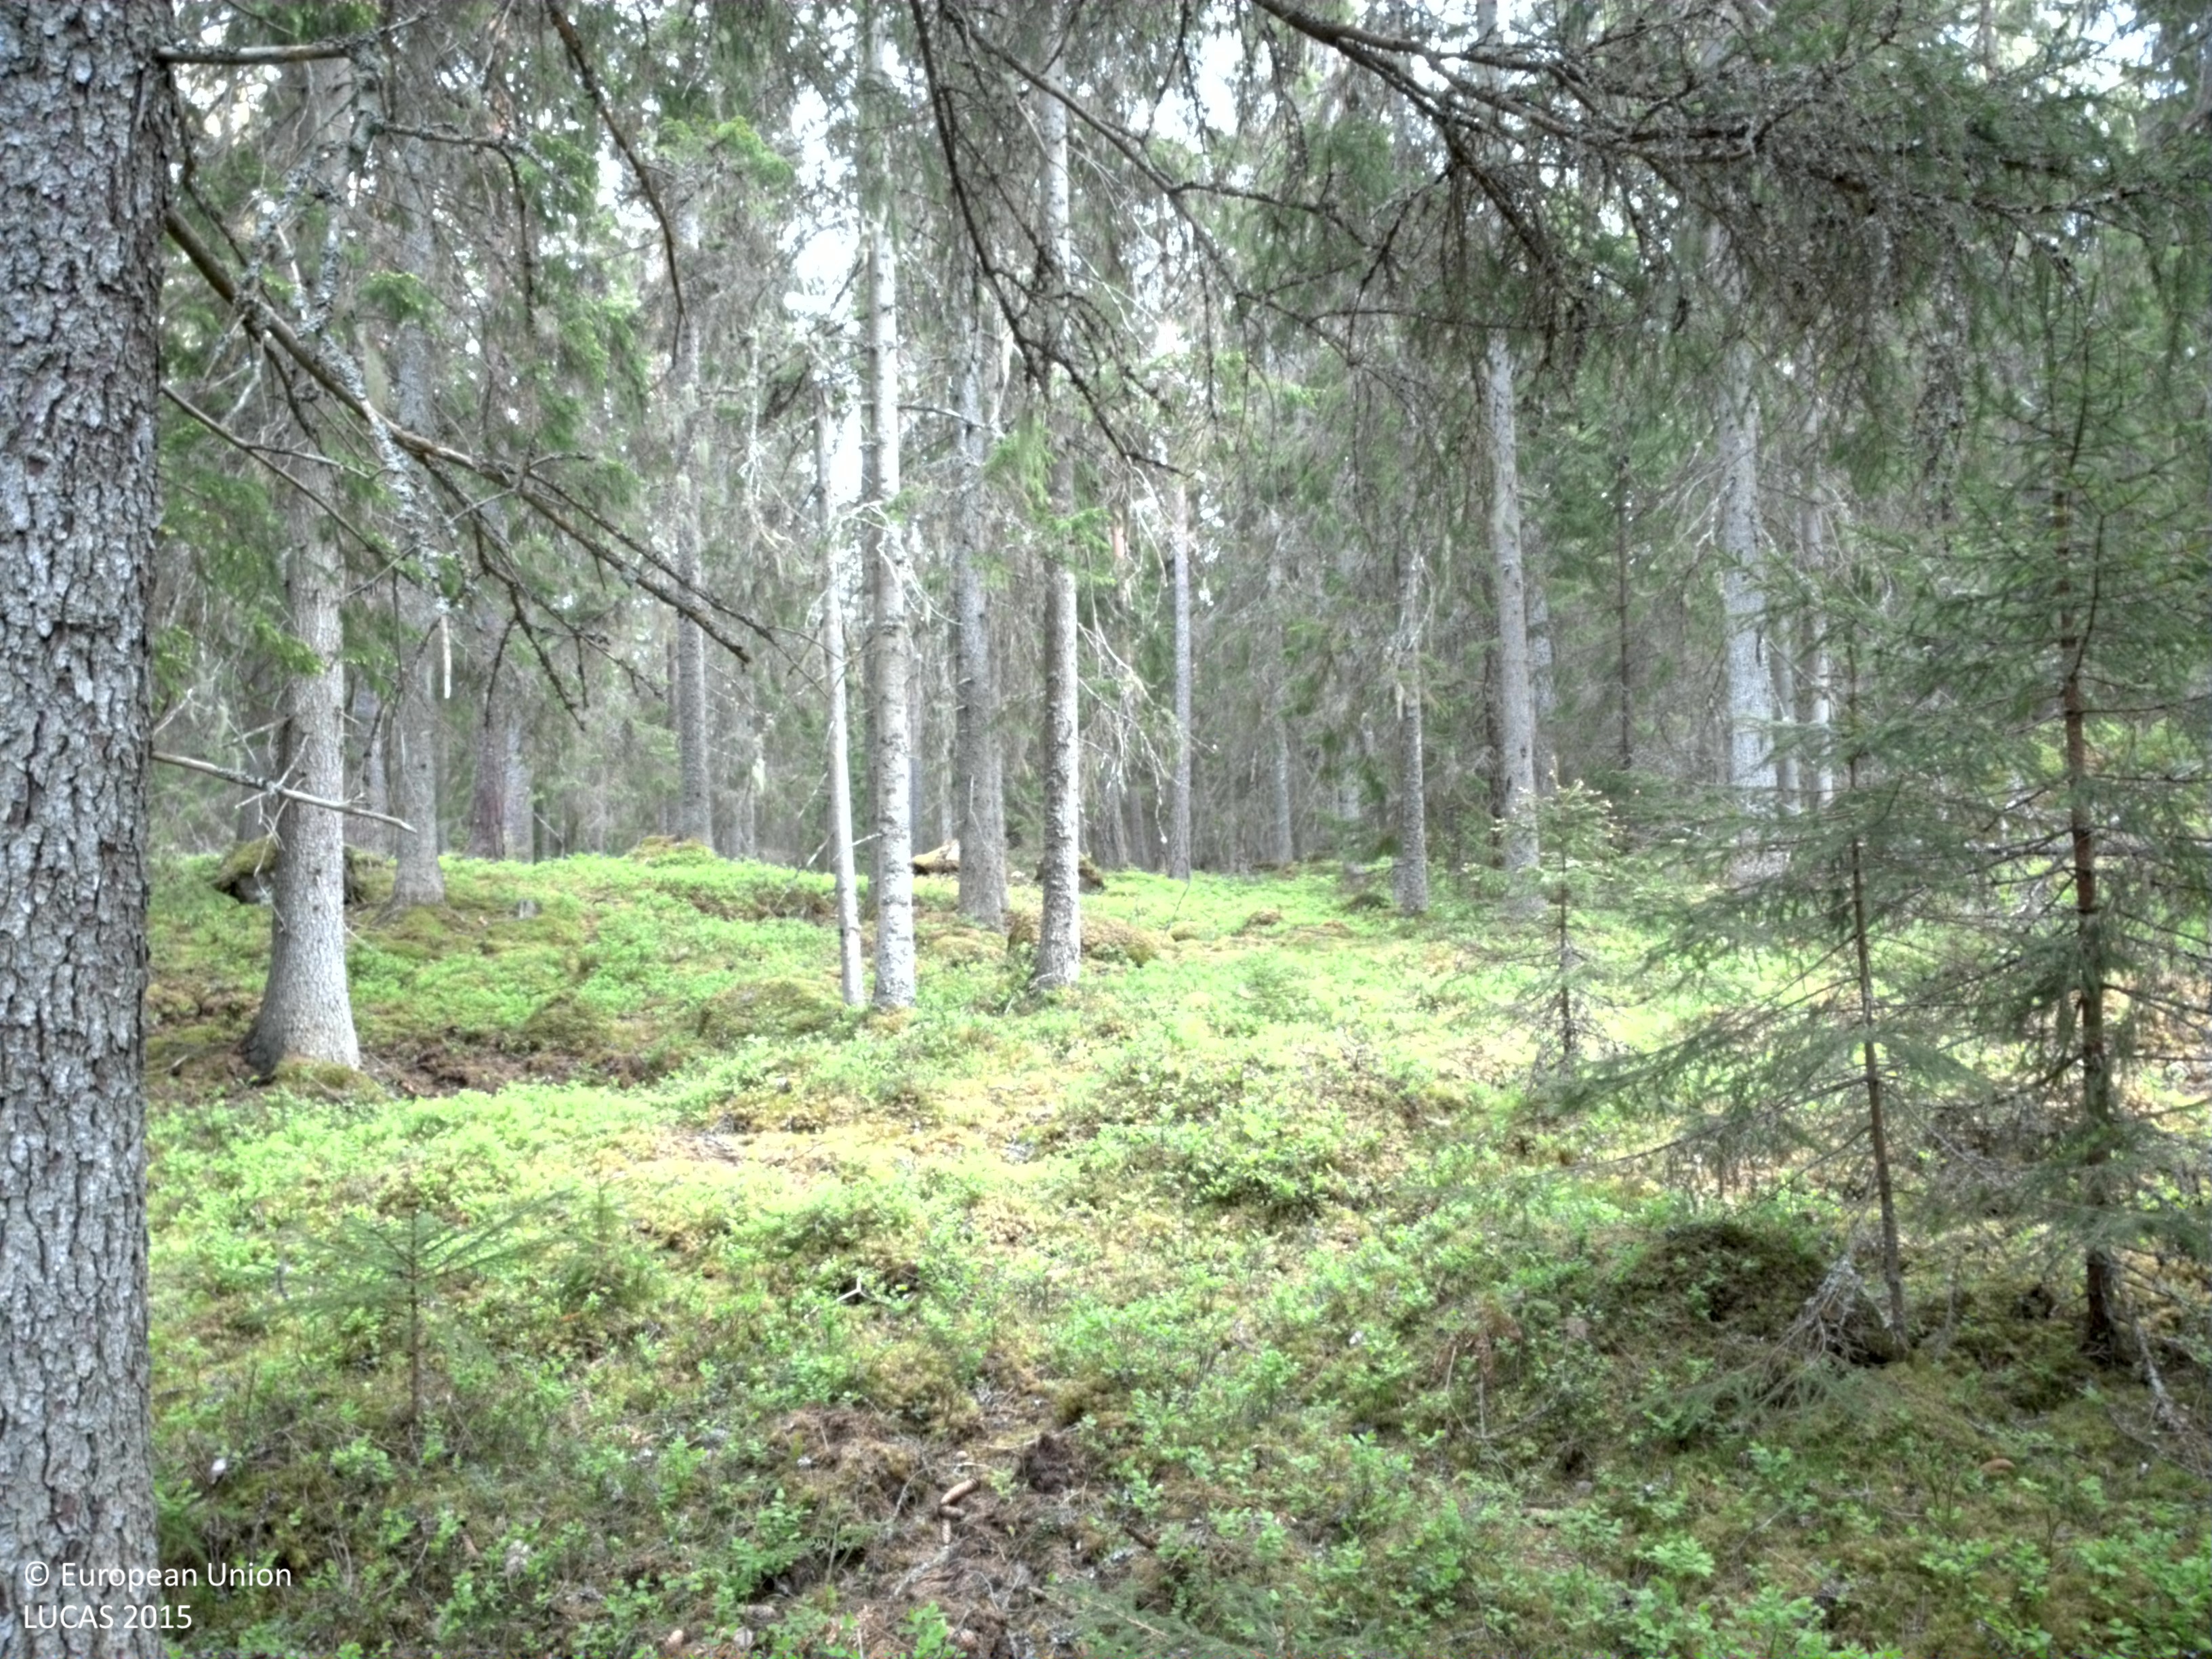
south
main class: Woodland
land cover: Spruce dominated coniferous woodland
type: boreal forest
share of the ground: 50 - 75 %
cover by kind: coniferous forest trees 50 %, shrubs 25 %, lichens and mosses 25 %
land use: Forestry
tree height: > 5 m
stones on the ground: 10 - 25 %
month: May
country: SE
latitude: 57.4435
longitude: 15.4117
